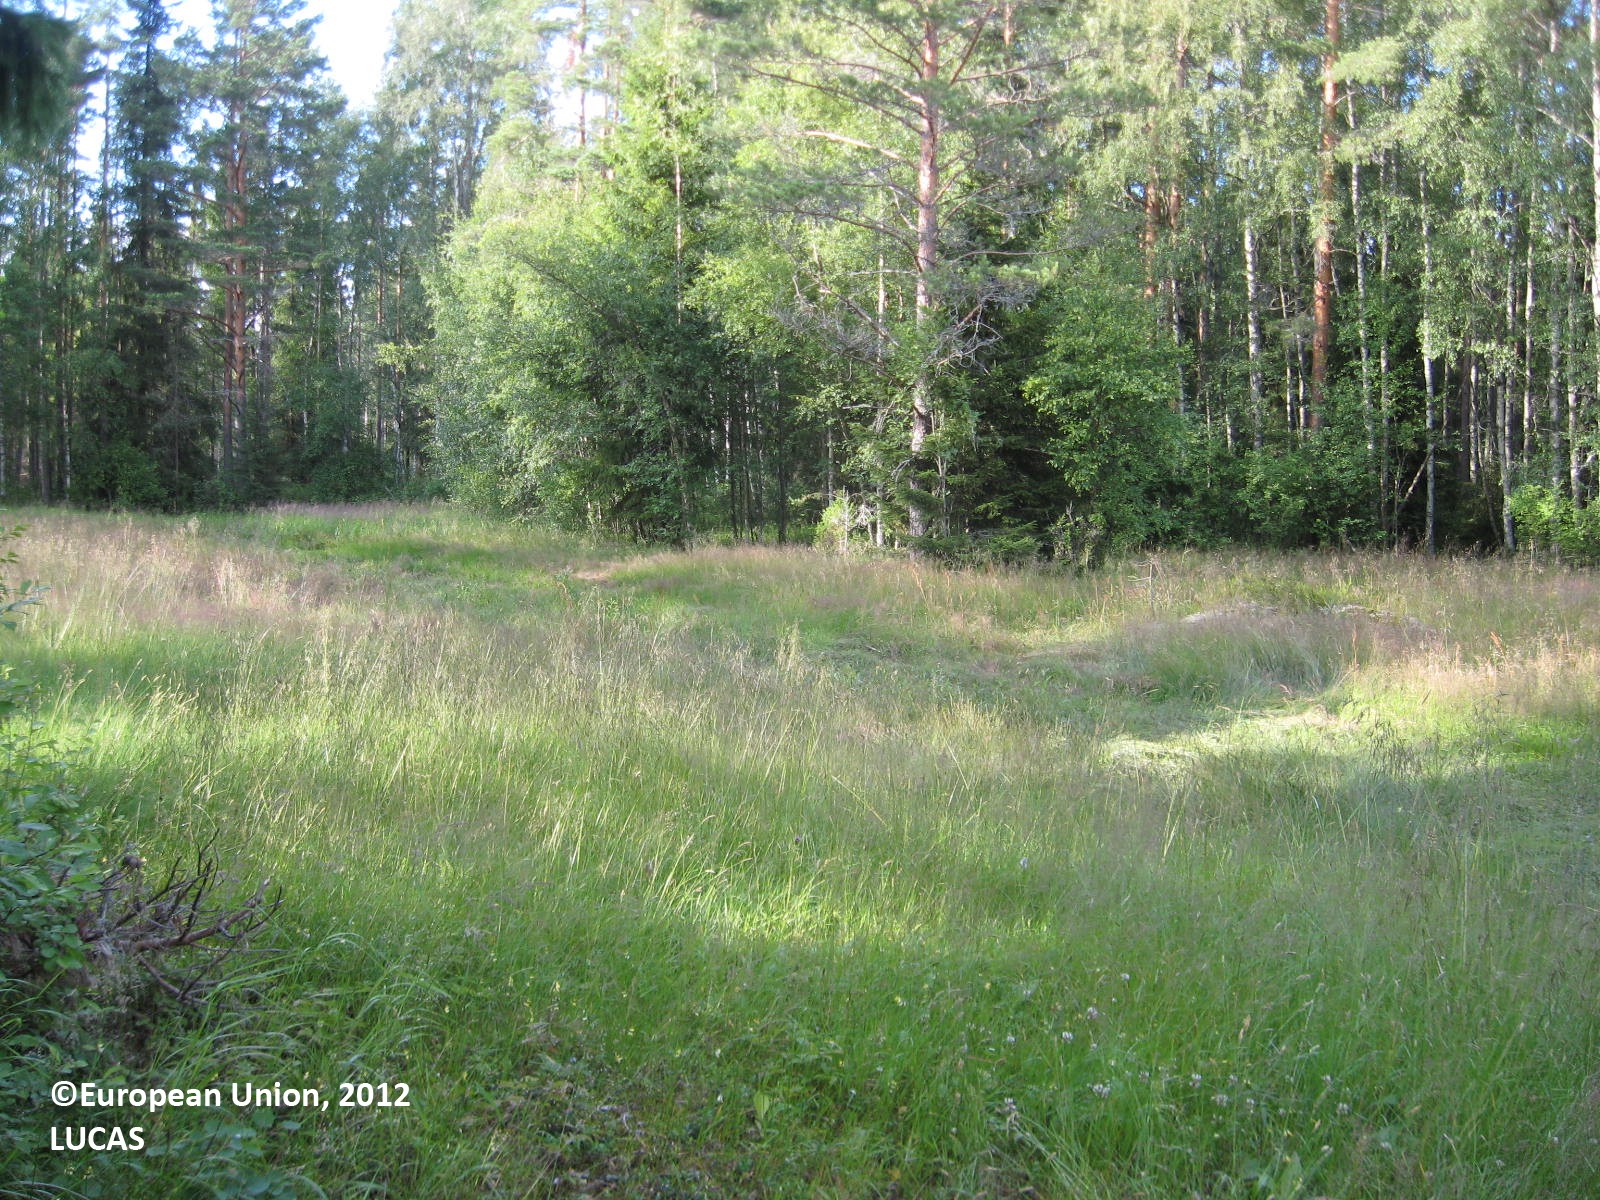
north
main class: Grassland
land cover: Grassland without tree/shrub cover
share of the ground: > 75 %
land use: Fallow land
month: July
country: FI
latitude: 62.0337
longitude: 21.6125
